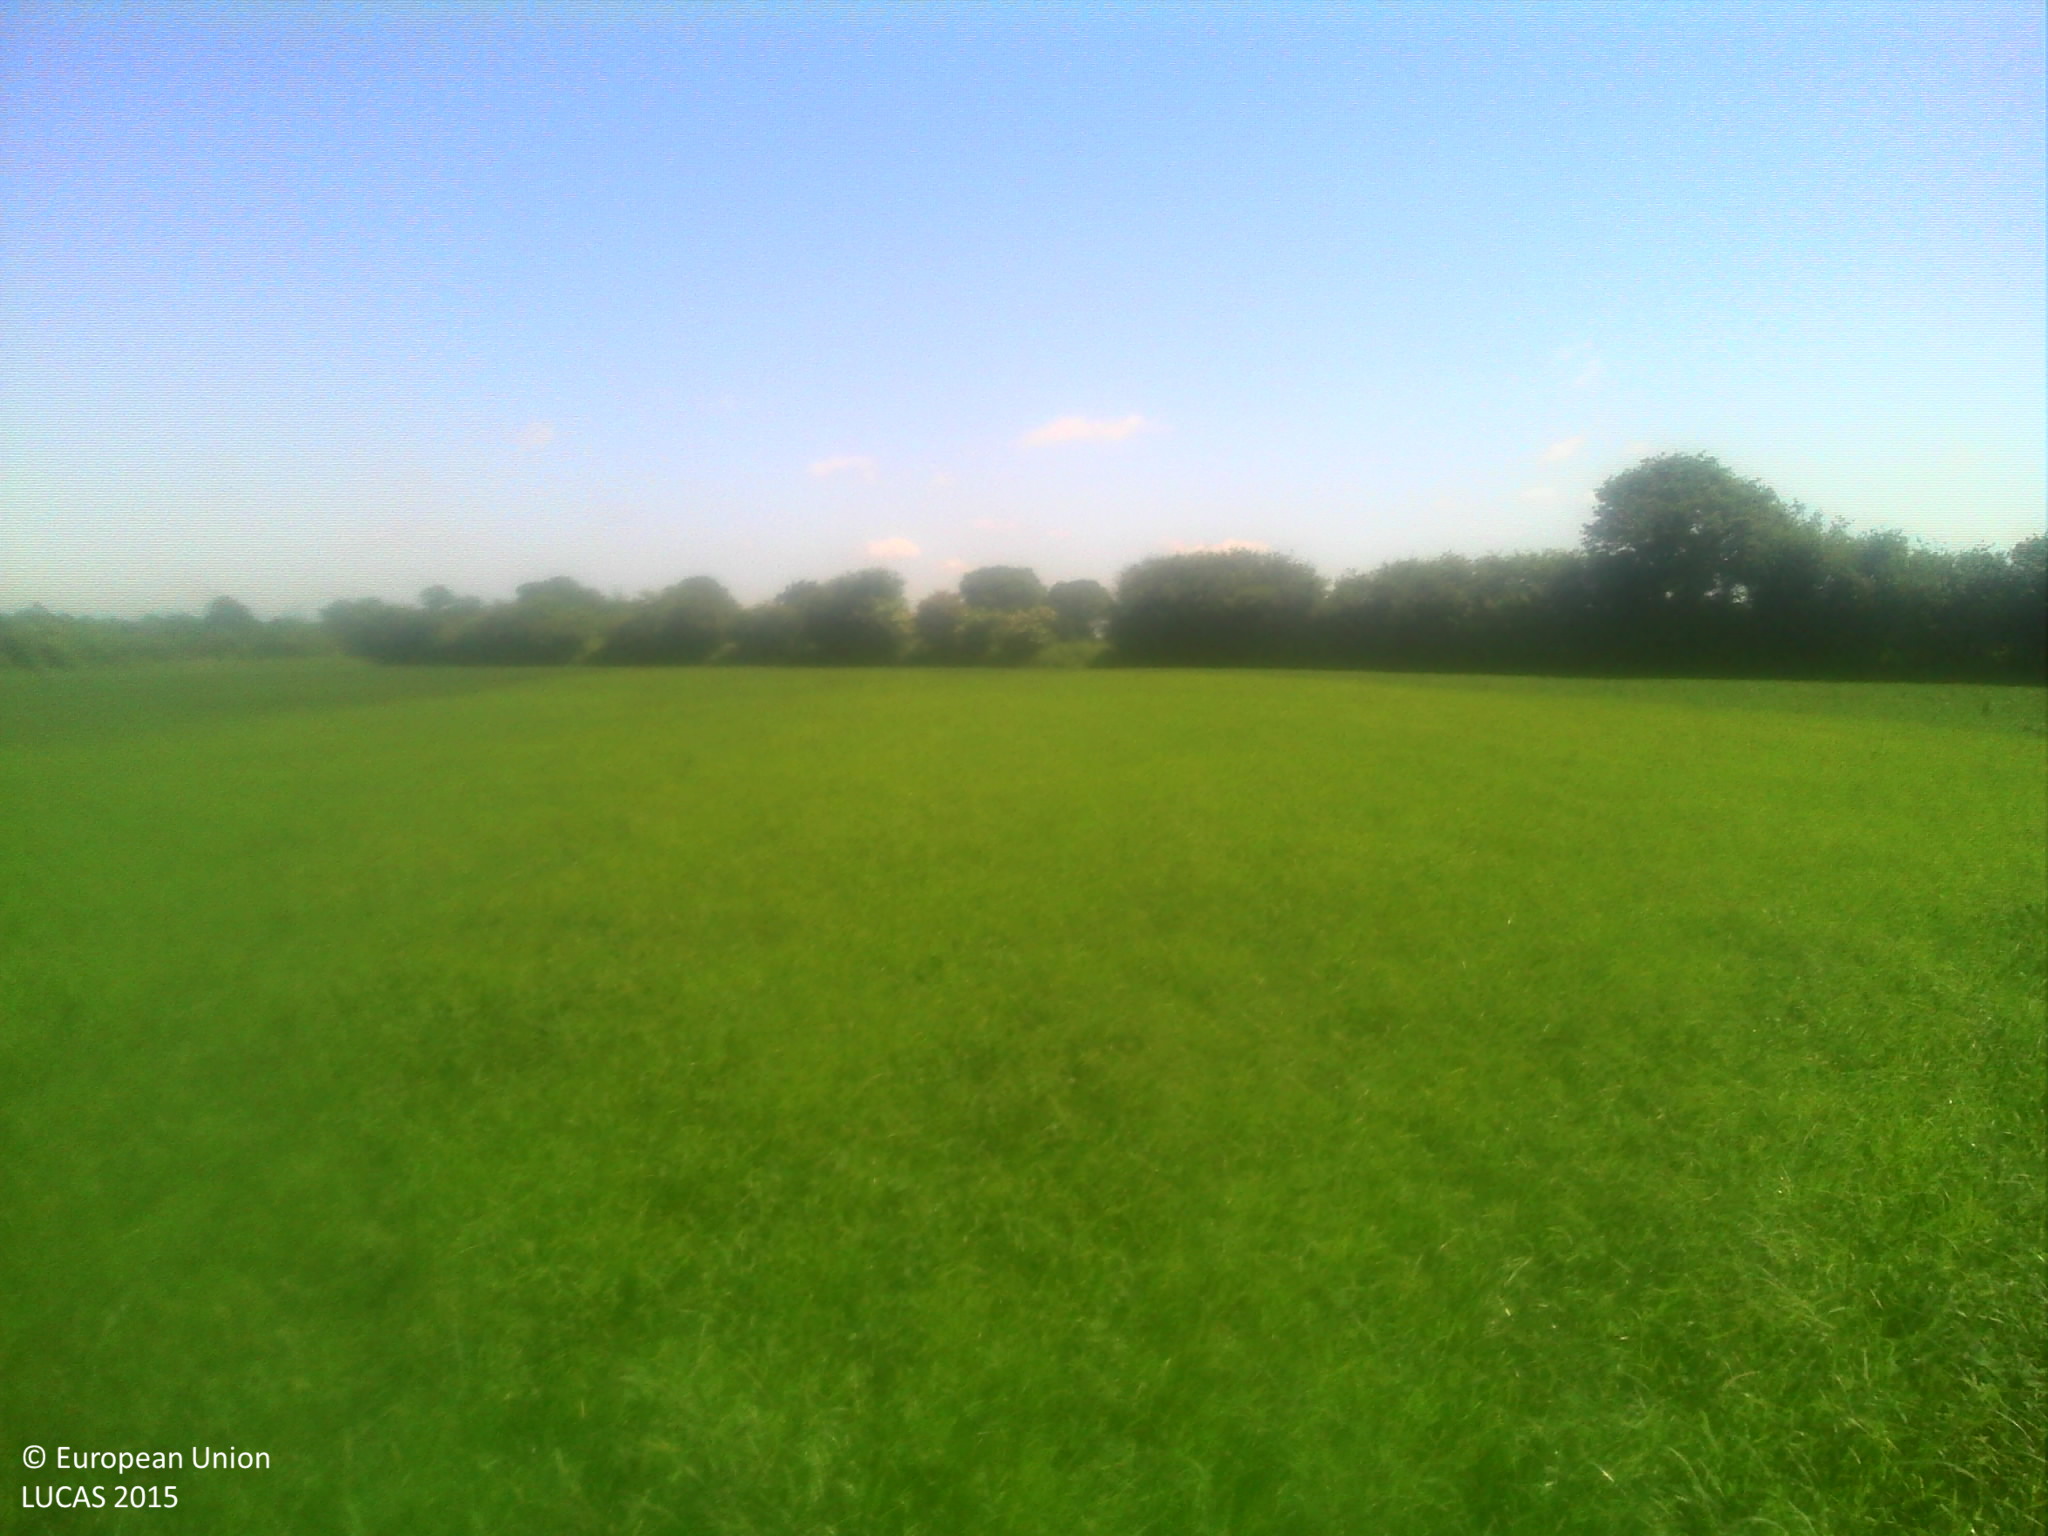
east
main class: Cropland
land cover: Temporary grasslands
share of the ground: > 75 %
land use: Agriculture (excluding fallow land and kitchen gardens)
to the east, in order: Temporary grasslands; Abandoned hedges; Common wheat; Tracks; Single bushes/trees; Managed hedges; Ditches and canals; Grass margins; Paved roads, cycling and walking lanes
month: June
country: FR
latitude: 49.6158
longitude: -1.5240
